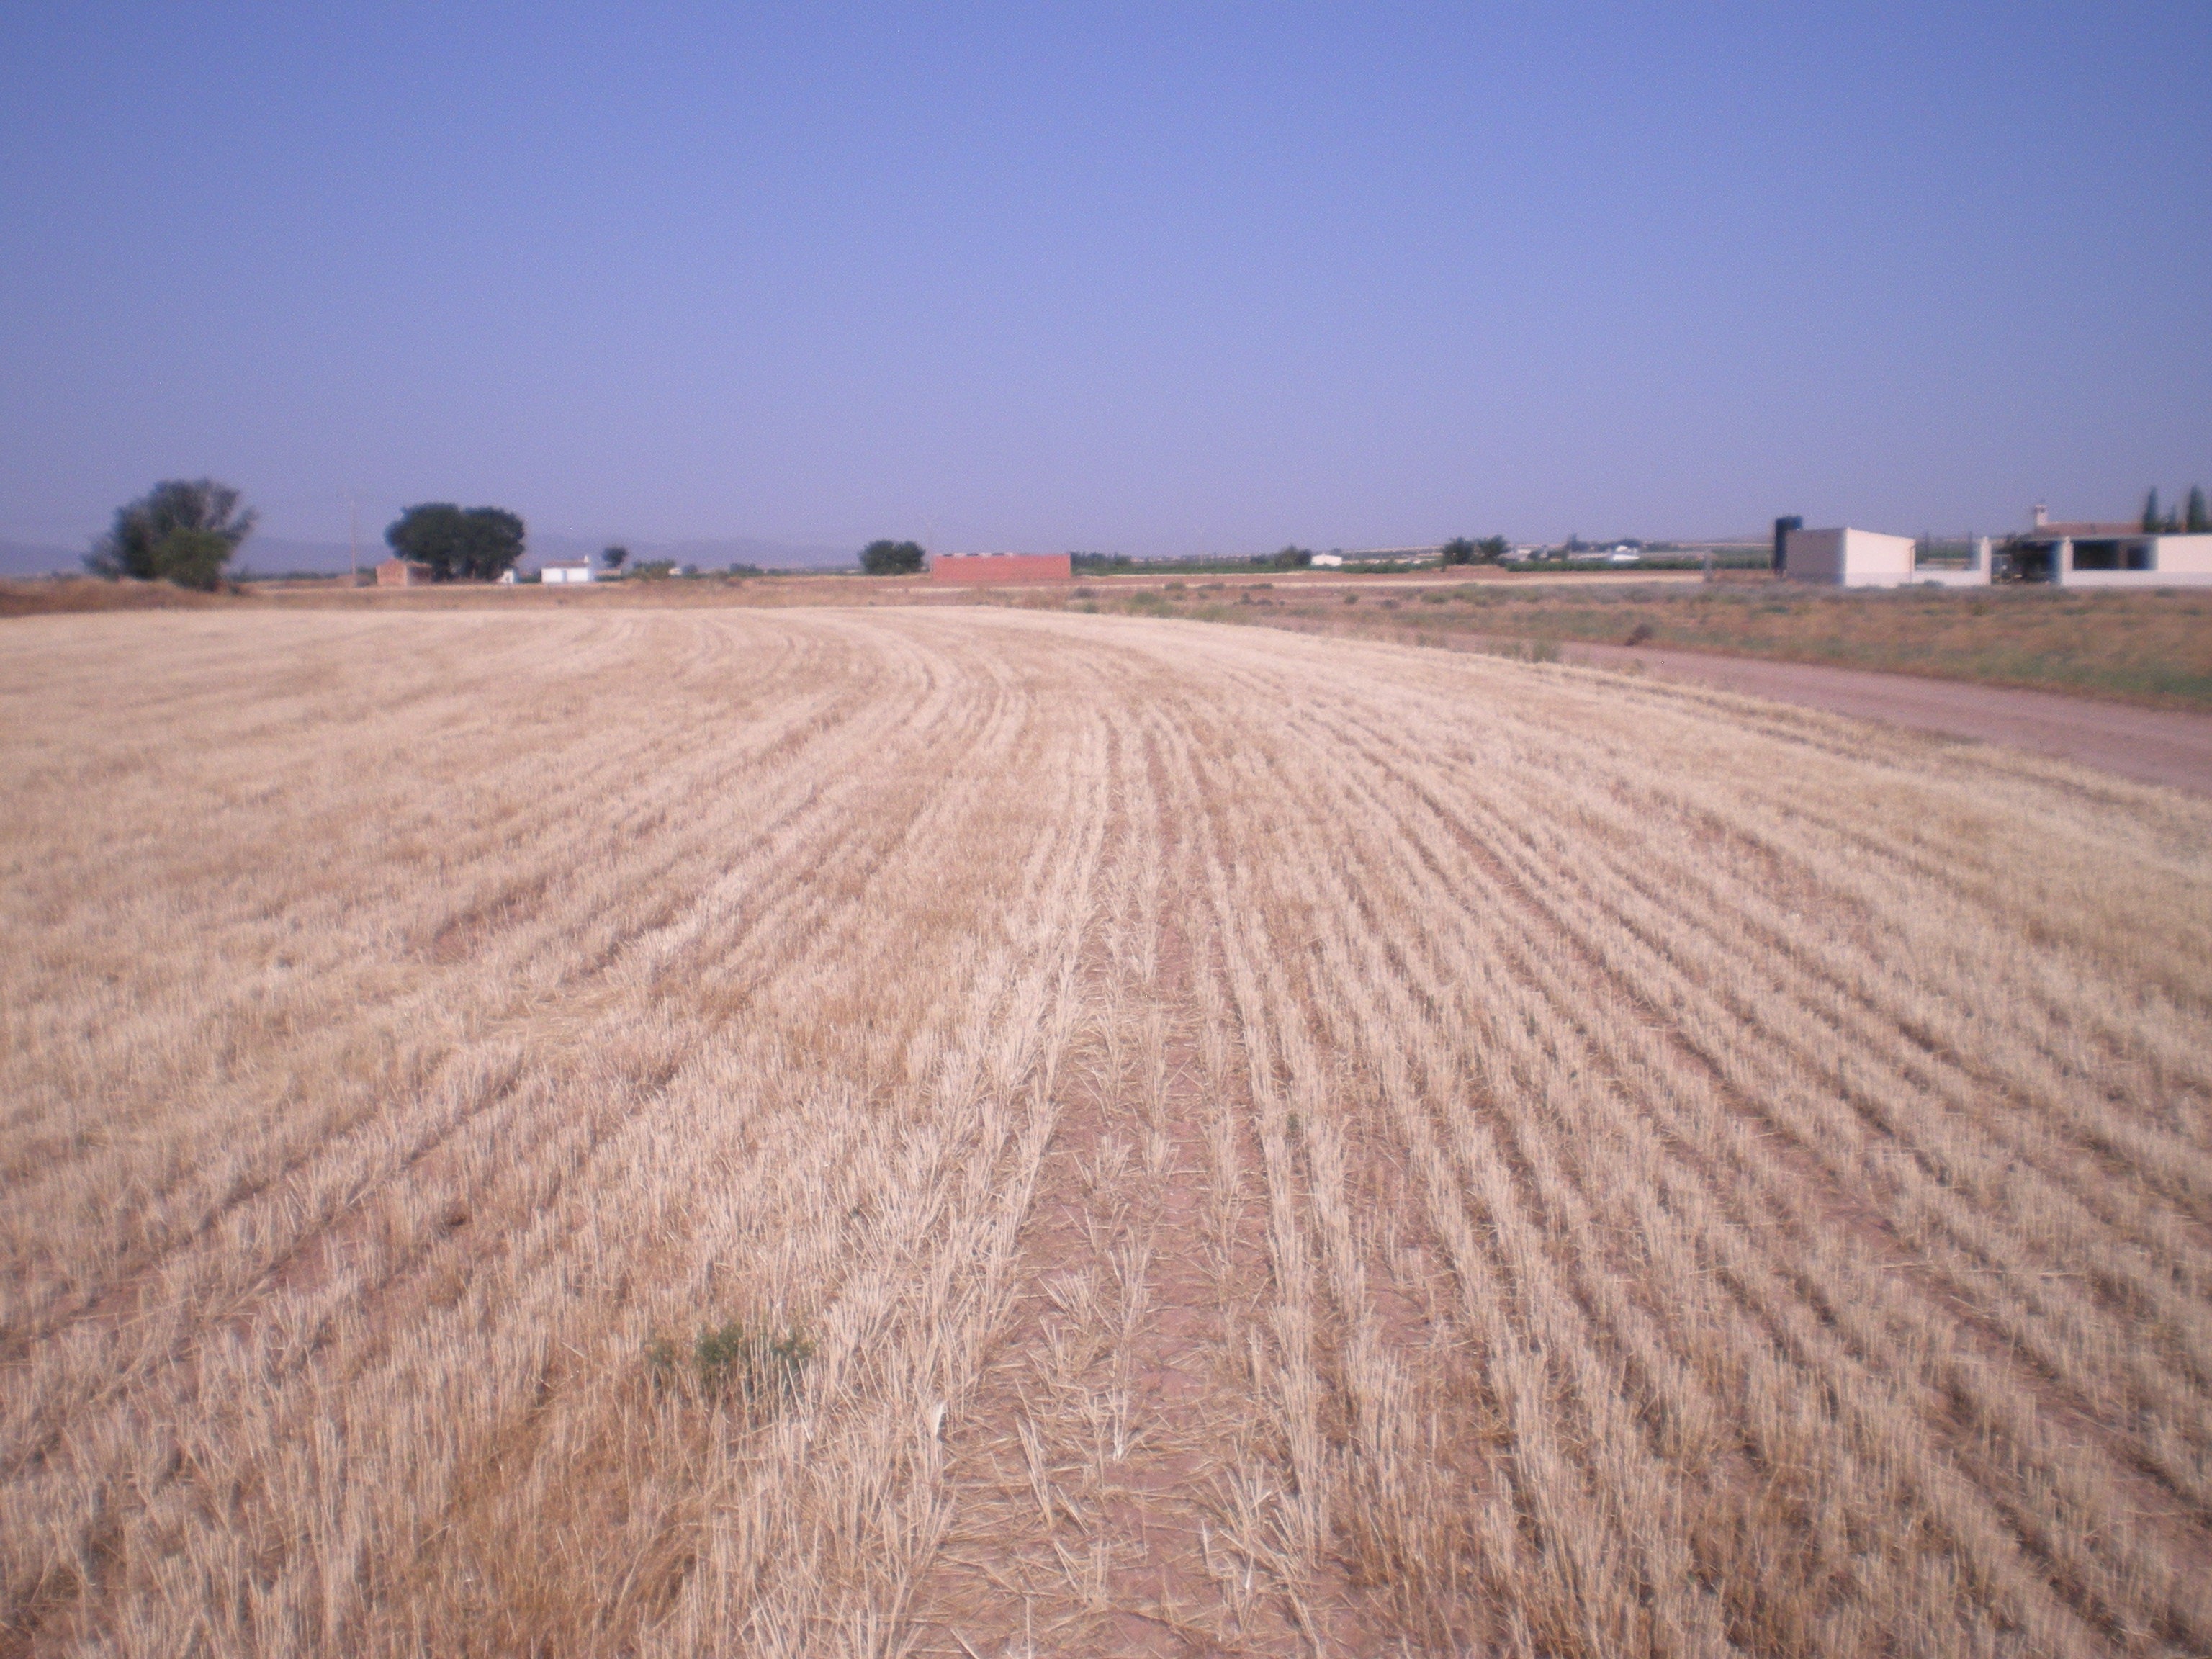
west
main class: Cropland
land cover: Barley
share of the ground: < 10 %
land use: Agriculture (excluding fallow land and kitchen gardens)
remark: Harvested field
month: July
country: ES
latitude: 39.4214
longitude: -3.3667
